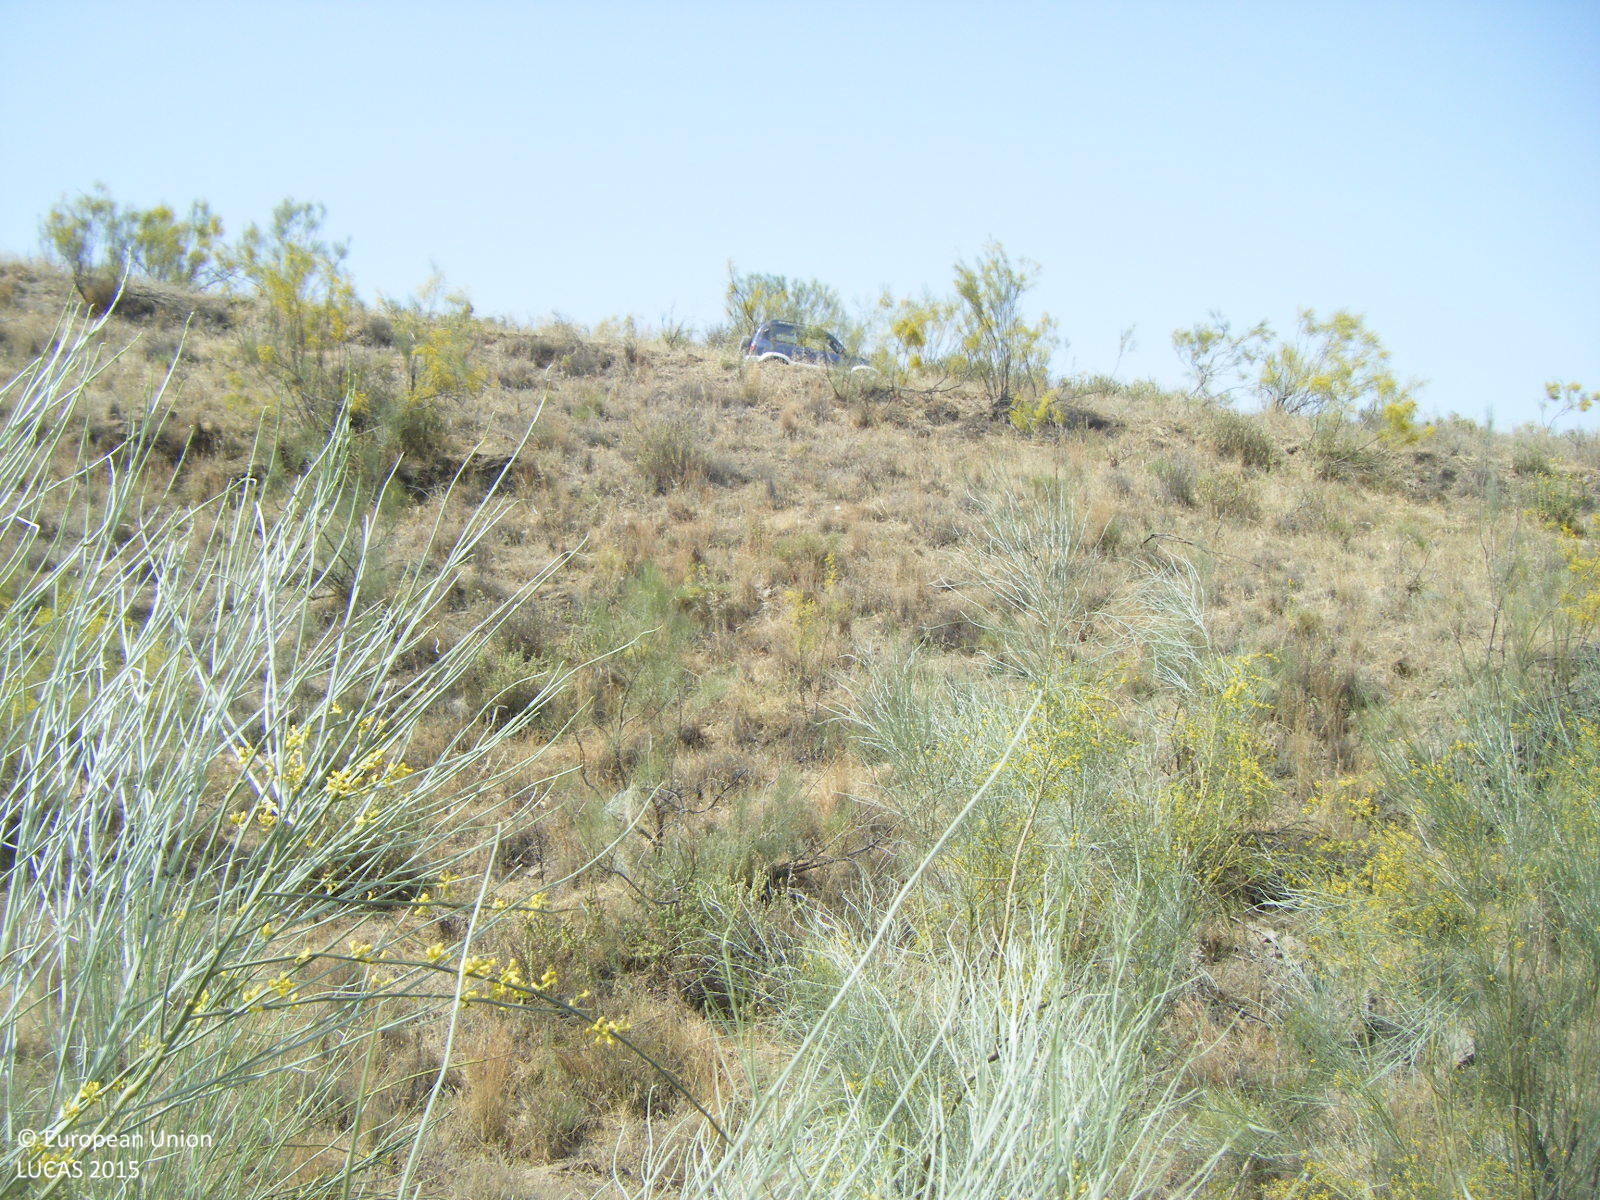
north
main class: Shrubland
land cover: Shrubland without tree cover
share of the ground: 50 - 75 %
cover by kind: shrubs 50 %, herbaceous plants 50 %
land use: Semi-natural and natural areas not in use
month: May
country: ES
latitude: 36.7639
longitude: -4.2269
